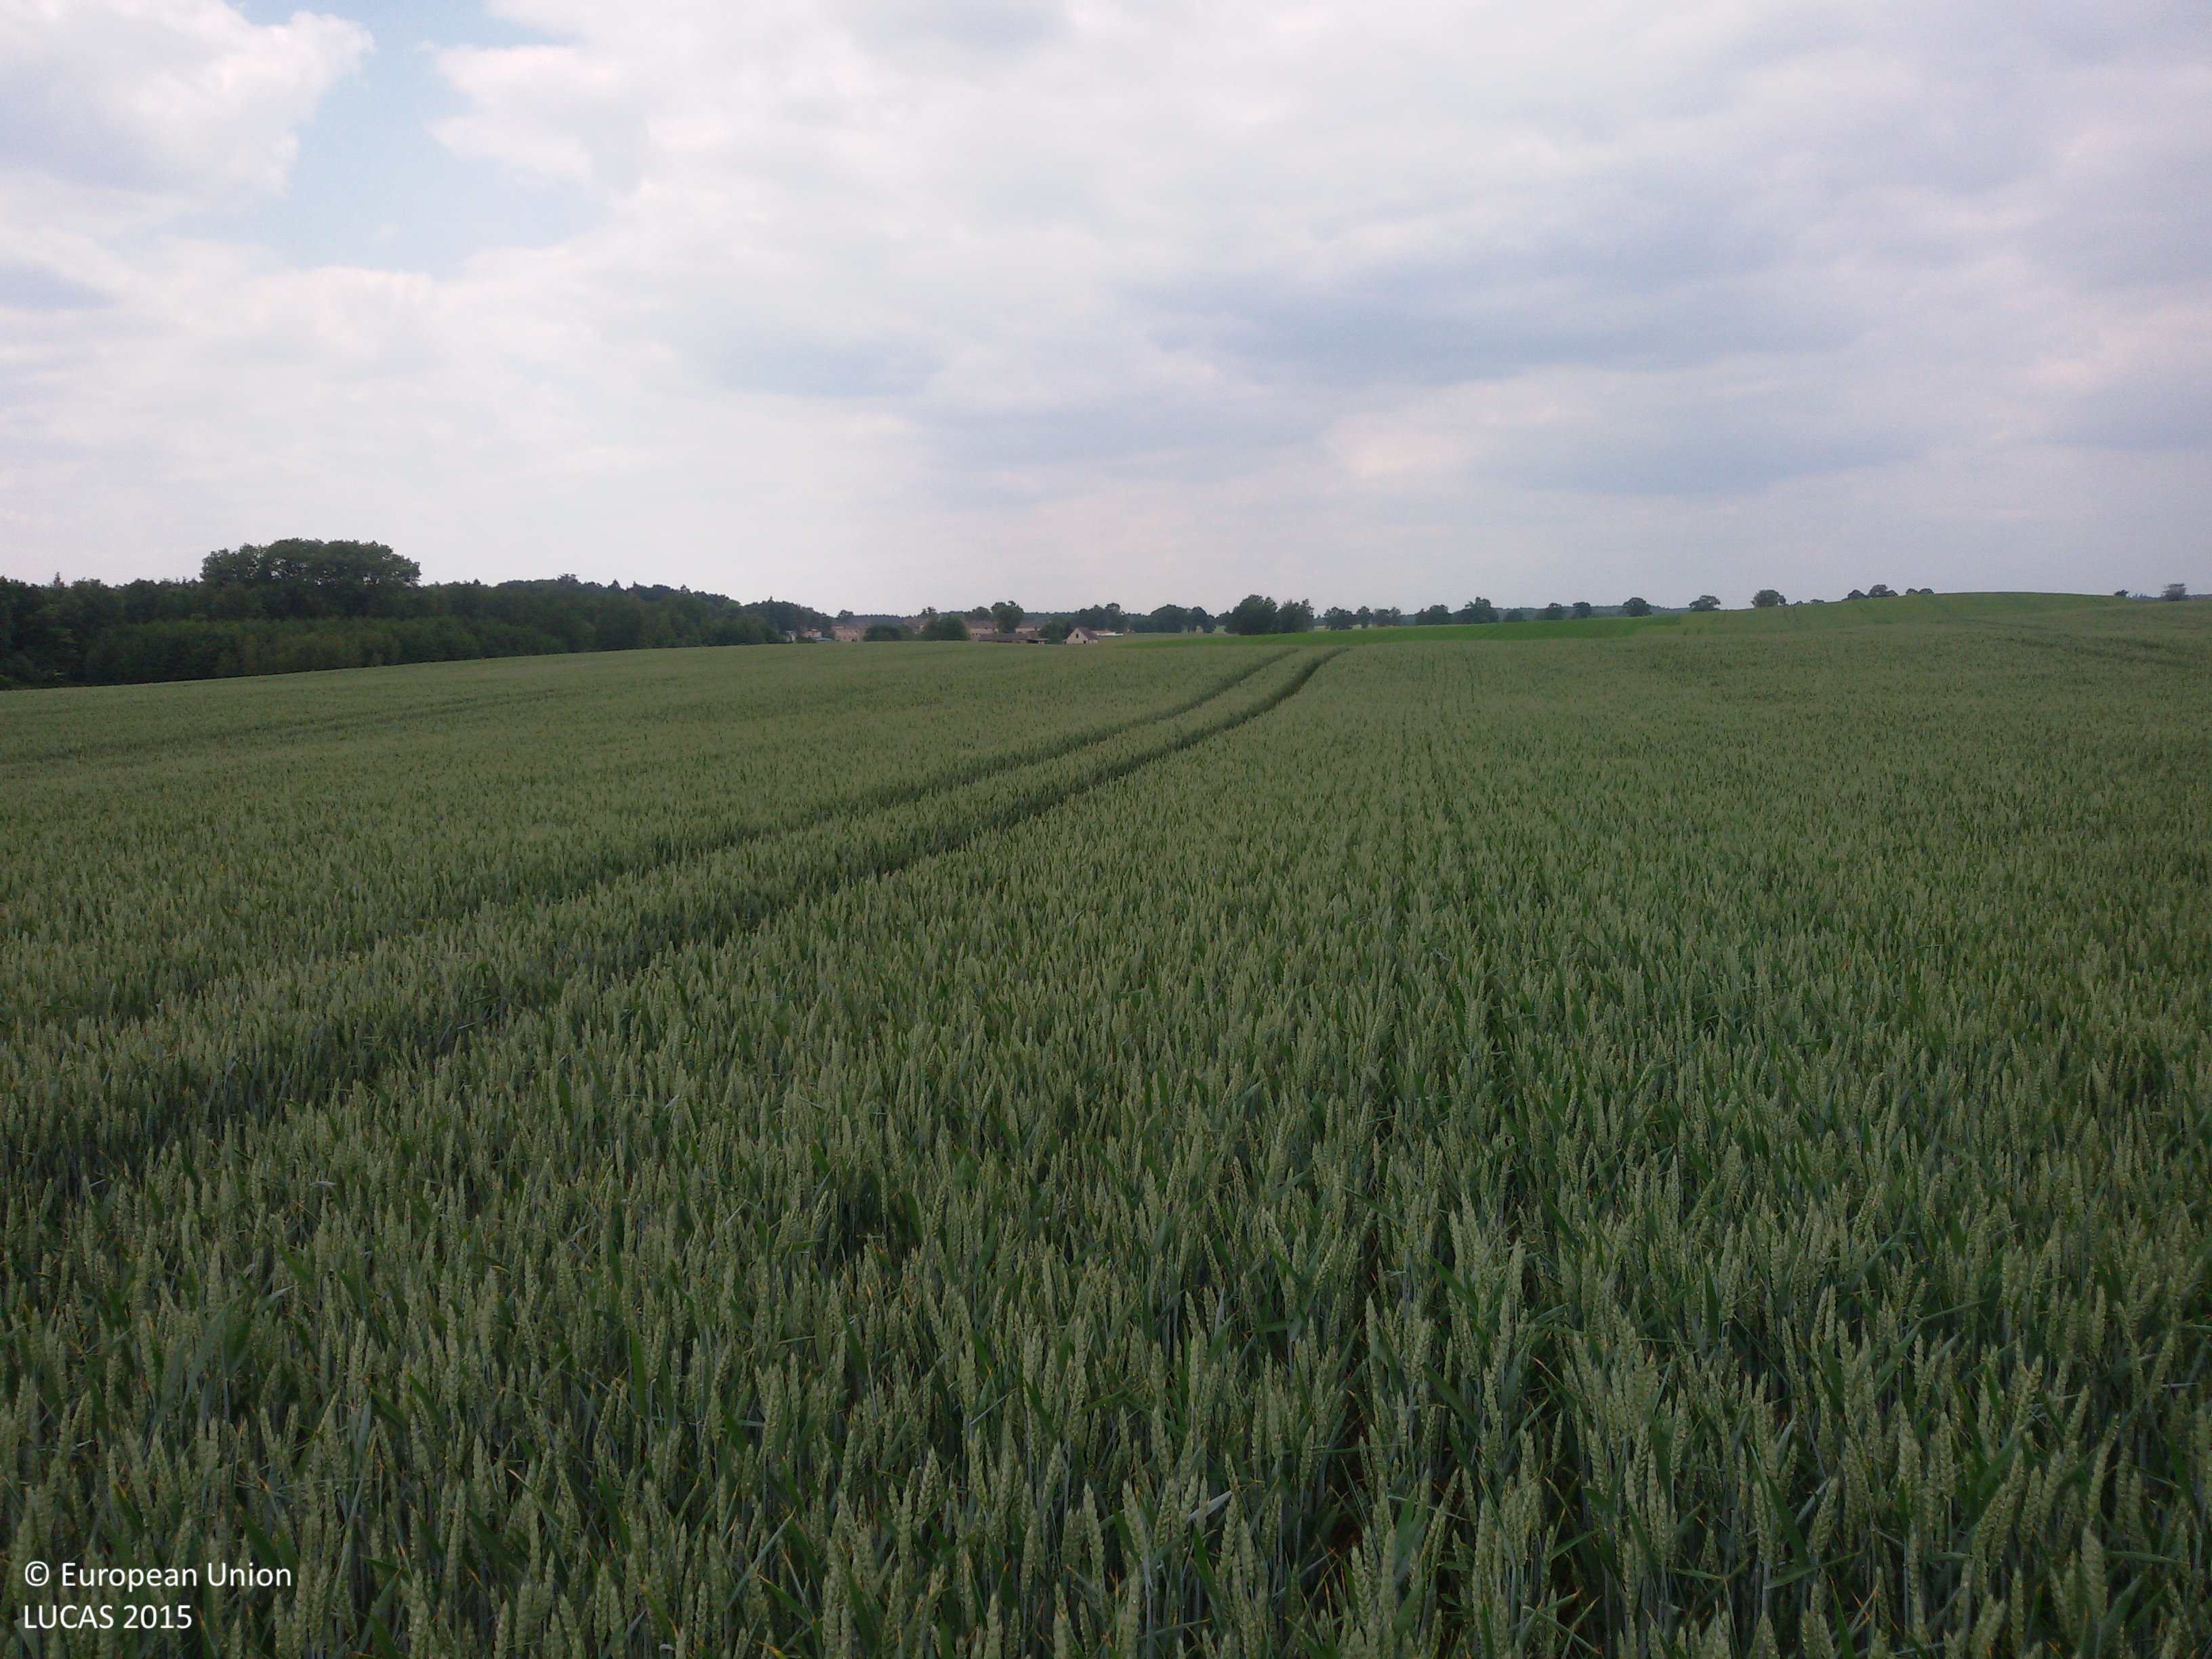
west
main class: Cropland
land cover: Common wheat
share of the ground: > 75 %
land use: Agriculture (excluding fallow land and kitchen gardens)
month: June
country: PL
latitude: 53.4292
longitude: 17.6734
